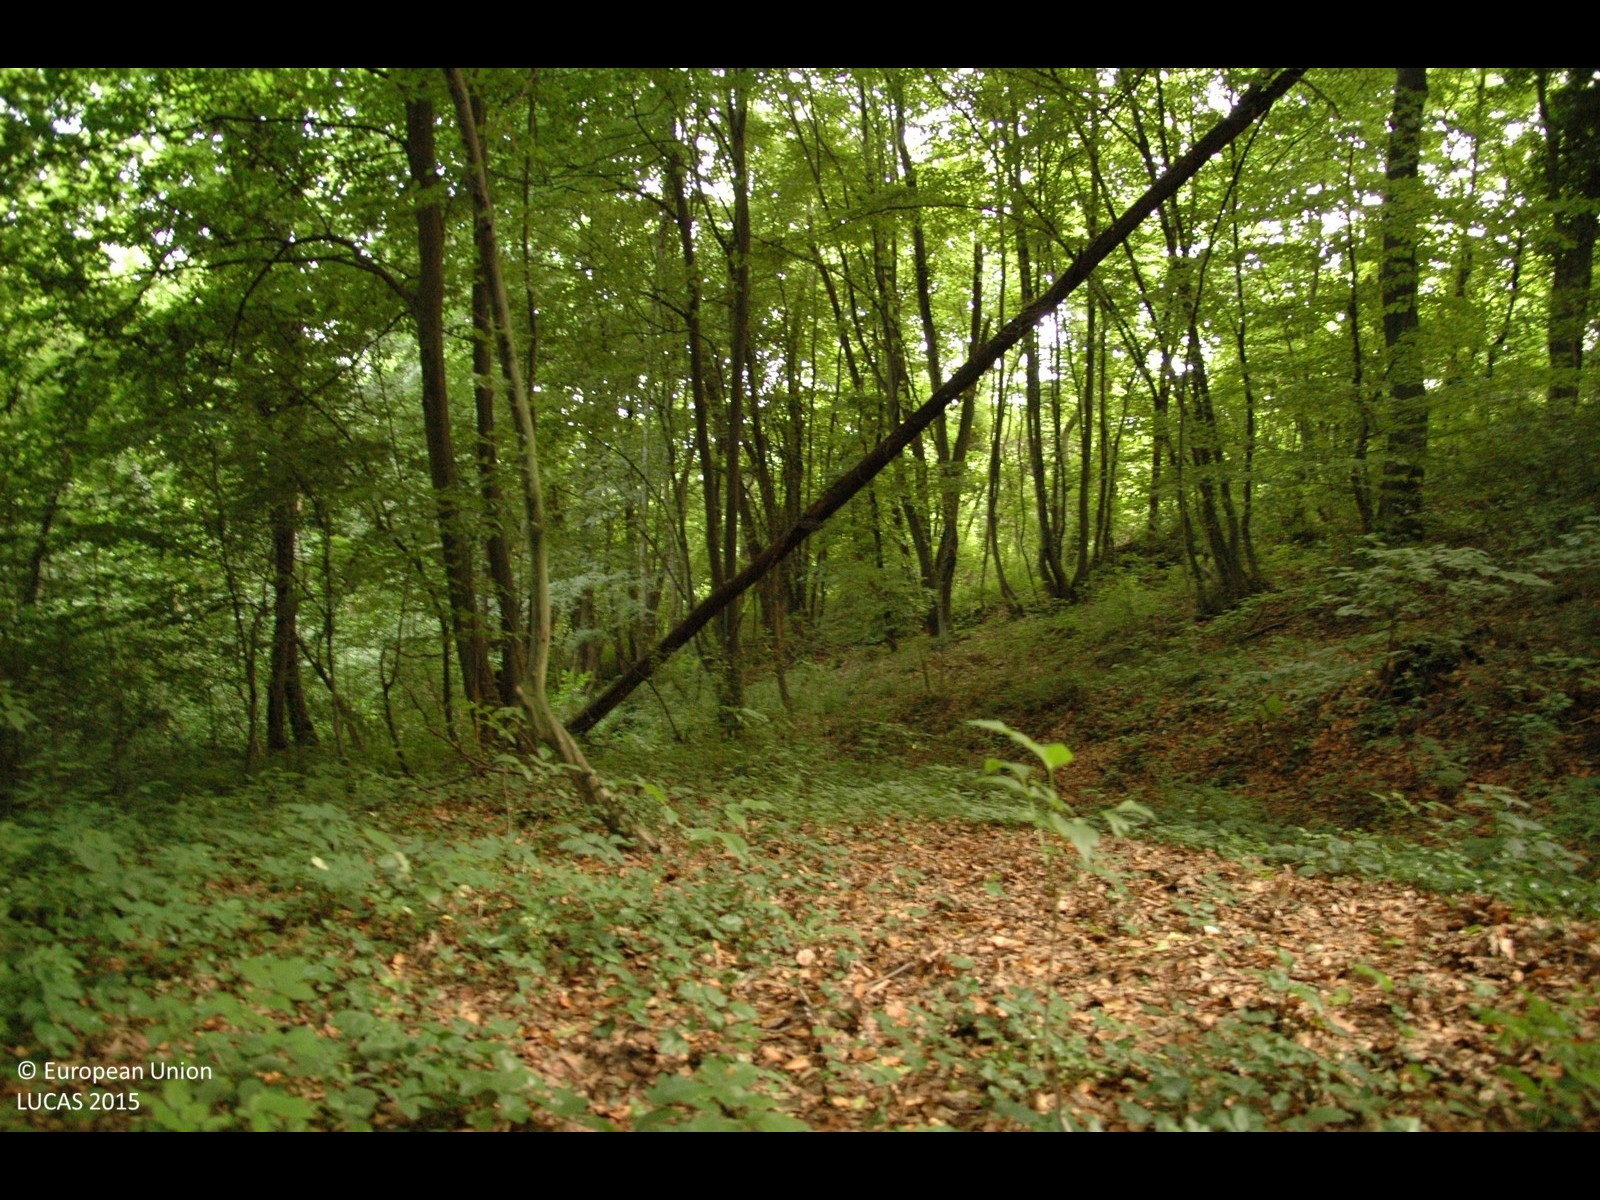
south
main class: Woodland
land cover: Broadleaved woodland
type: mesophytic deciduous forest
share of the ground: > 75 %
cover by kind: broadleaved forest trees 100 %
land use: Forestry
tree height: > 5 m
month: June
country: HR
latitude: 46.2275
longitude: 16.4702
